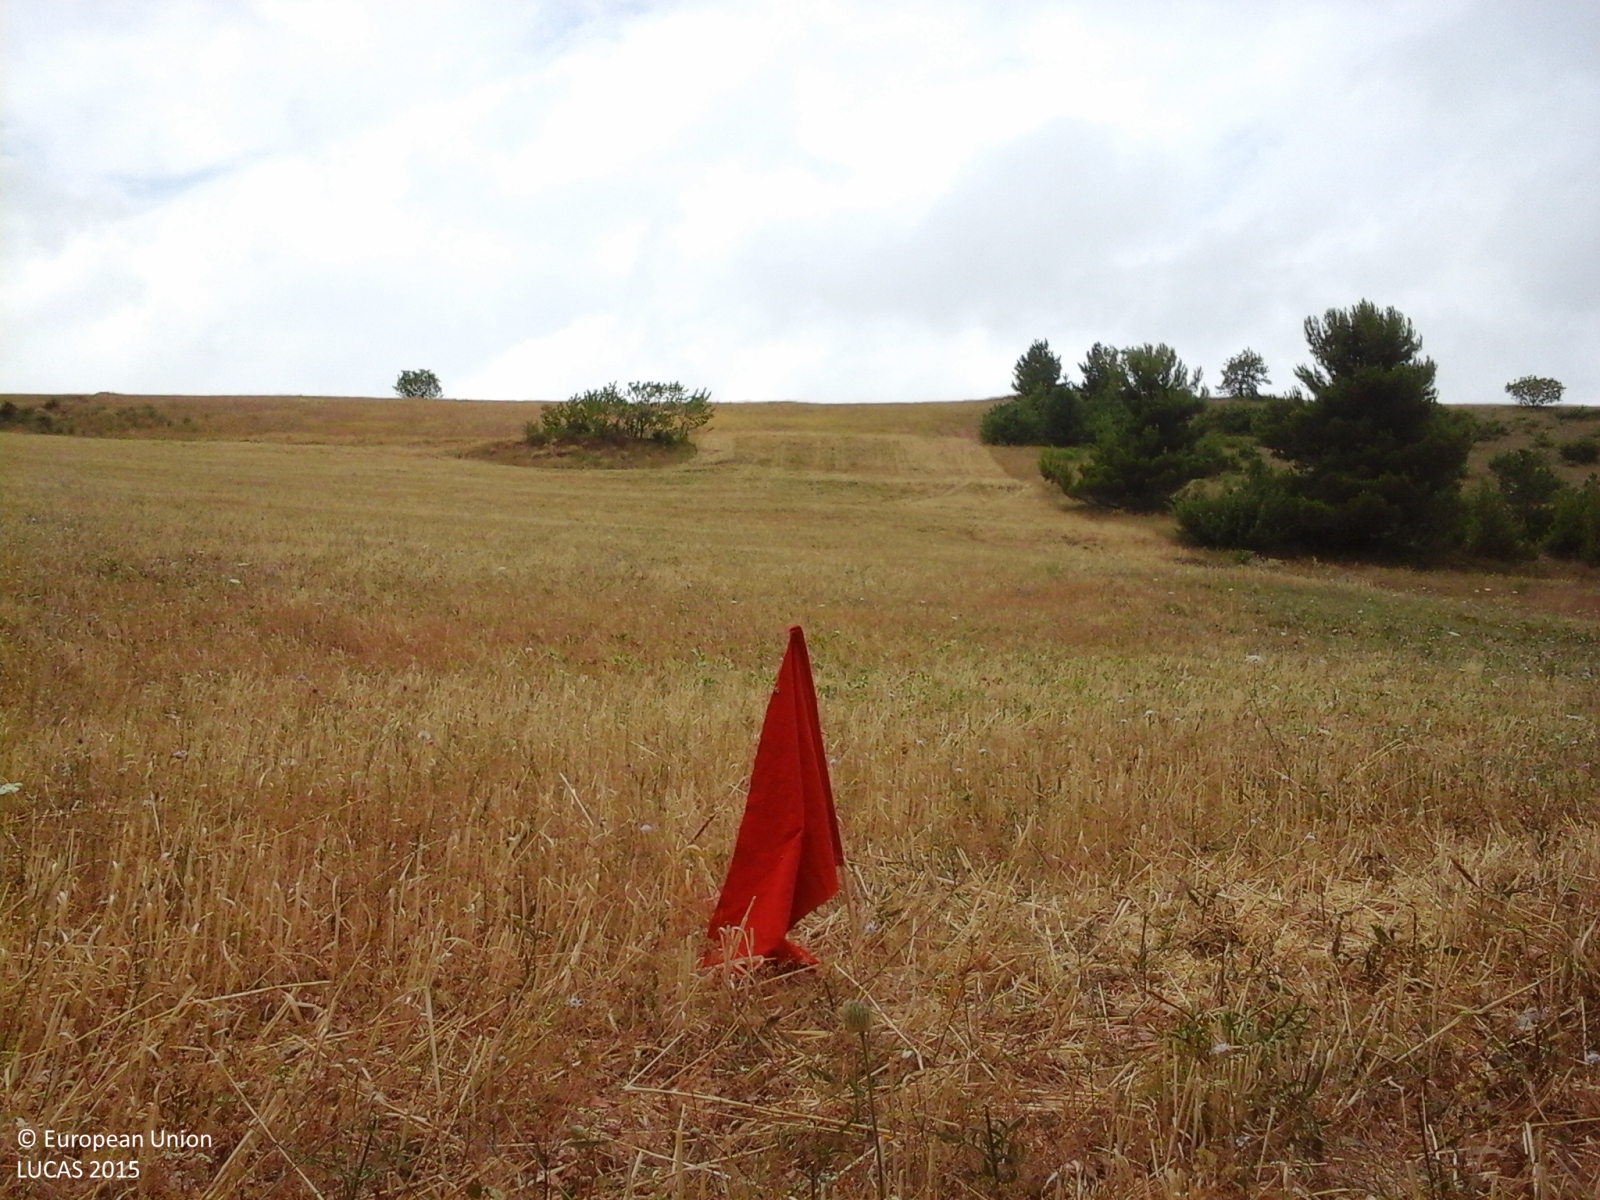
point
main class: Cropland
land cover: Triticale
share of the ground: > 75 %
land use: Agriculture (excluding fallow land and kitchen gardens)
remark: Harvested field
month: July
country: IT
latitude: 43.2380
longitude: 13.1318
